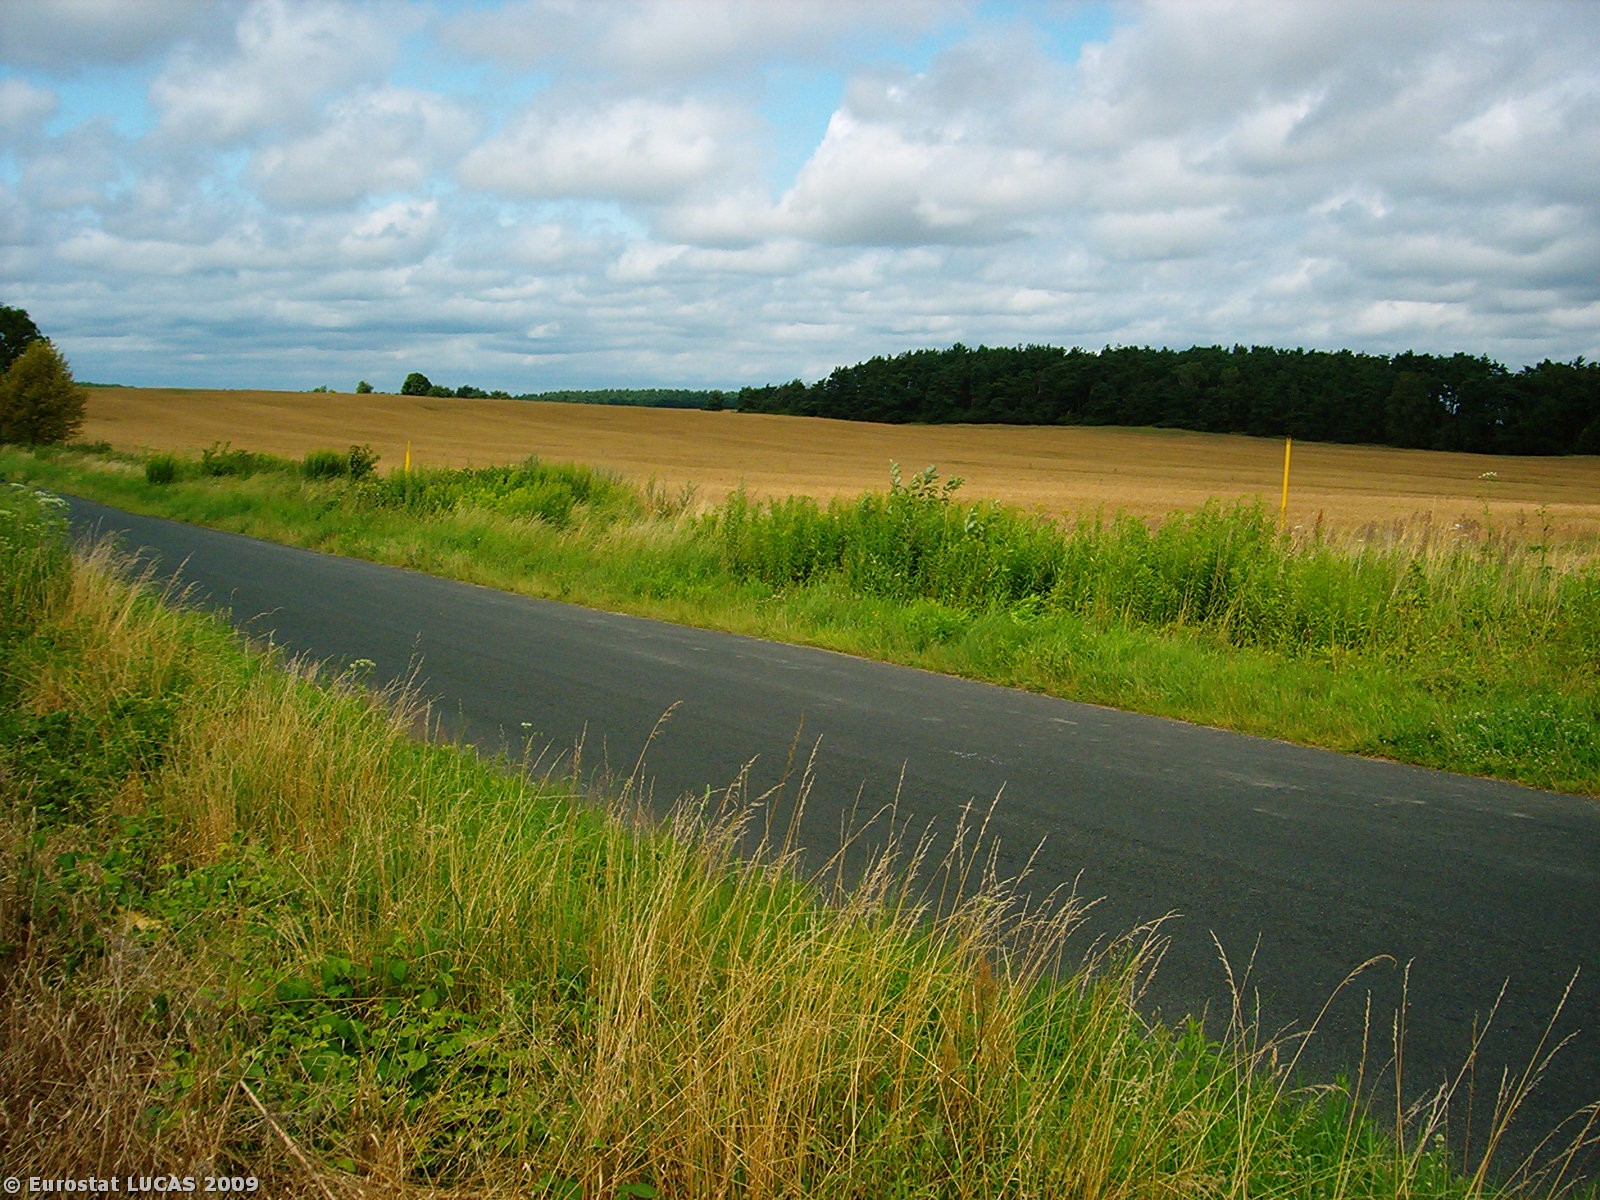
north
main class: Cropland
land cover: Rape and turnip rape
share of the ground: > 75 %
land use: Agriculture (excluding fallow land and kitchen gardens)
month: July
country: PL
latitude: 52.4540
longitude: 15.3747
